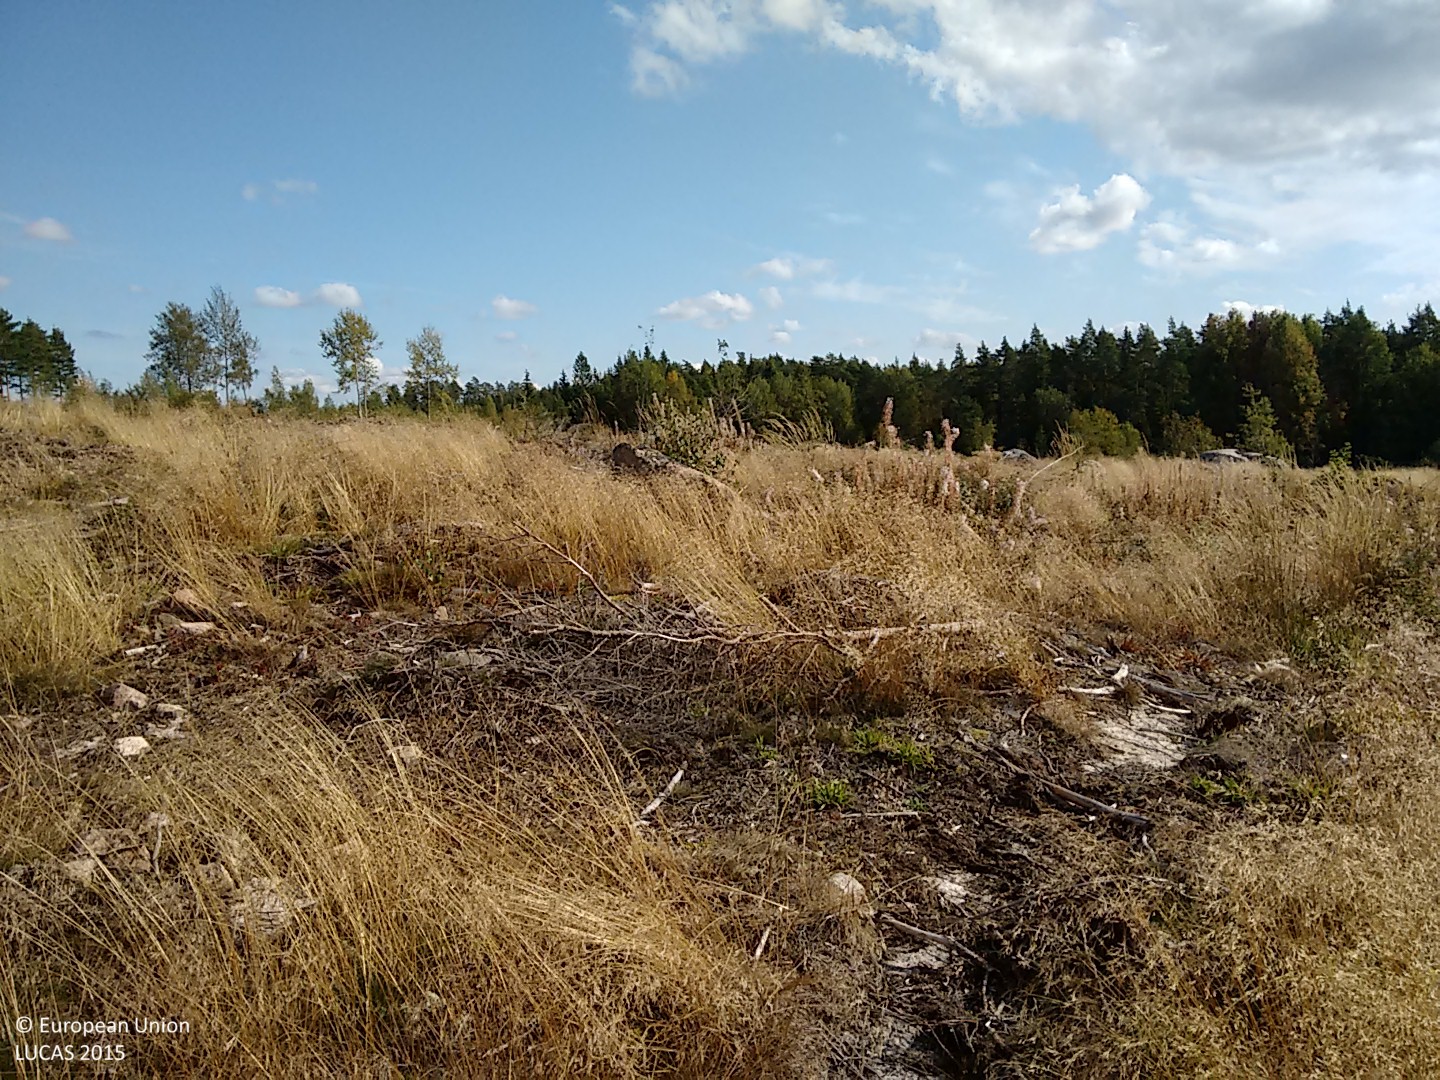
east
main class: Grassland
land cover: Grassland with sparse tree/shrub cover
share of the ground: > 75 %
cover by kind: herbaceous plants 80 %, consolidated bare surface 10 %, broadleaved forest trees 5 %, unconsolidated bare surface 5 %
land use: Forestry
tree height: < 5 m
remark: Clear cut
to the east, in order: Grassland with sparse tree/shrub cover; Broadleaved woodland; Ditches and canals; Barley; Grass margins; Potatoes; Rape and turnip rape; Pine dominated coniferous woodland; Pine dominated mixed woodland; Ditches and canals; Abandoned hedges; Grass margins; Tracks; Grass margins; Spruce dominated mixed woodland
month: September
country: FI
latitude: 60.9348
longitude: 21.6630
